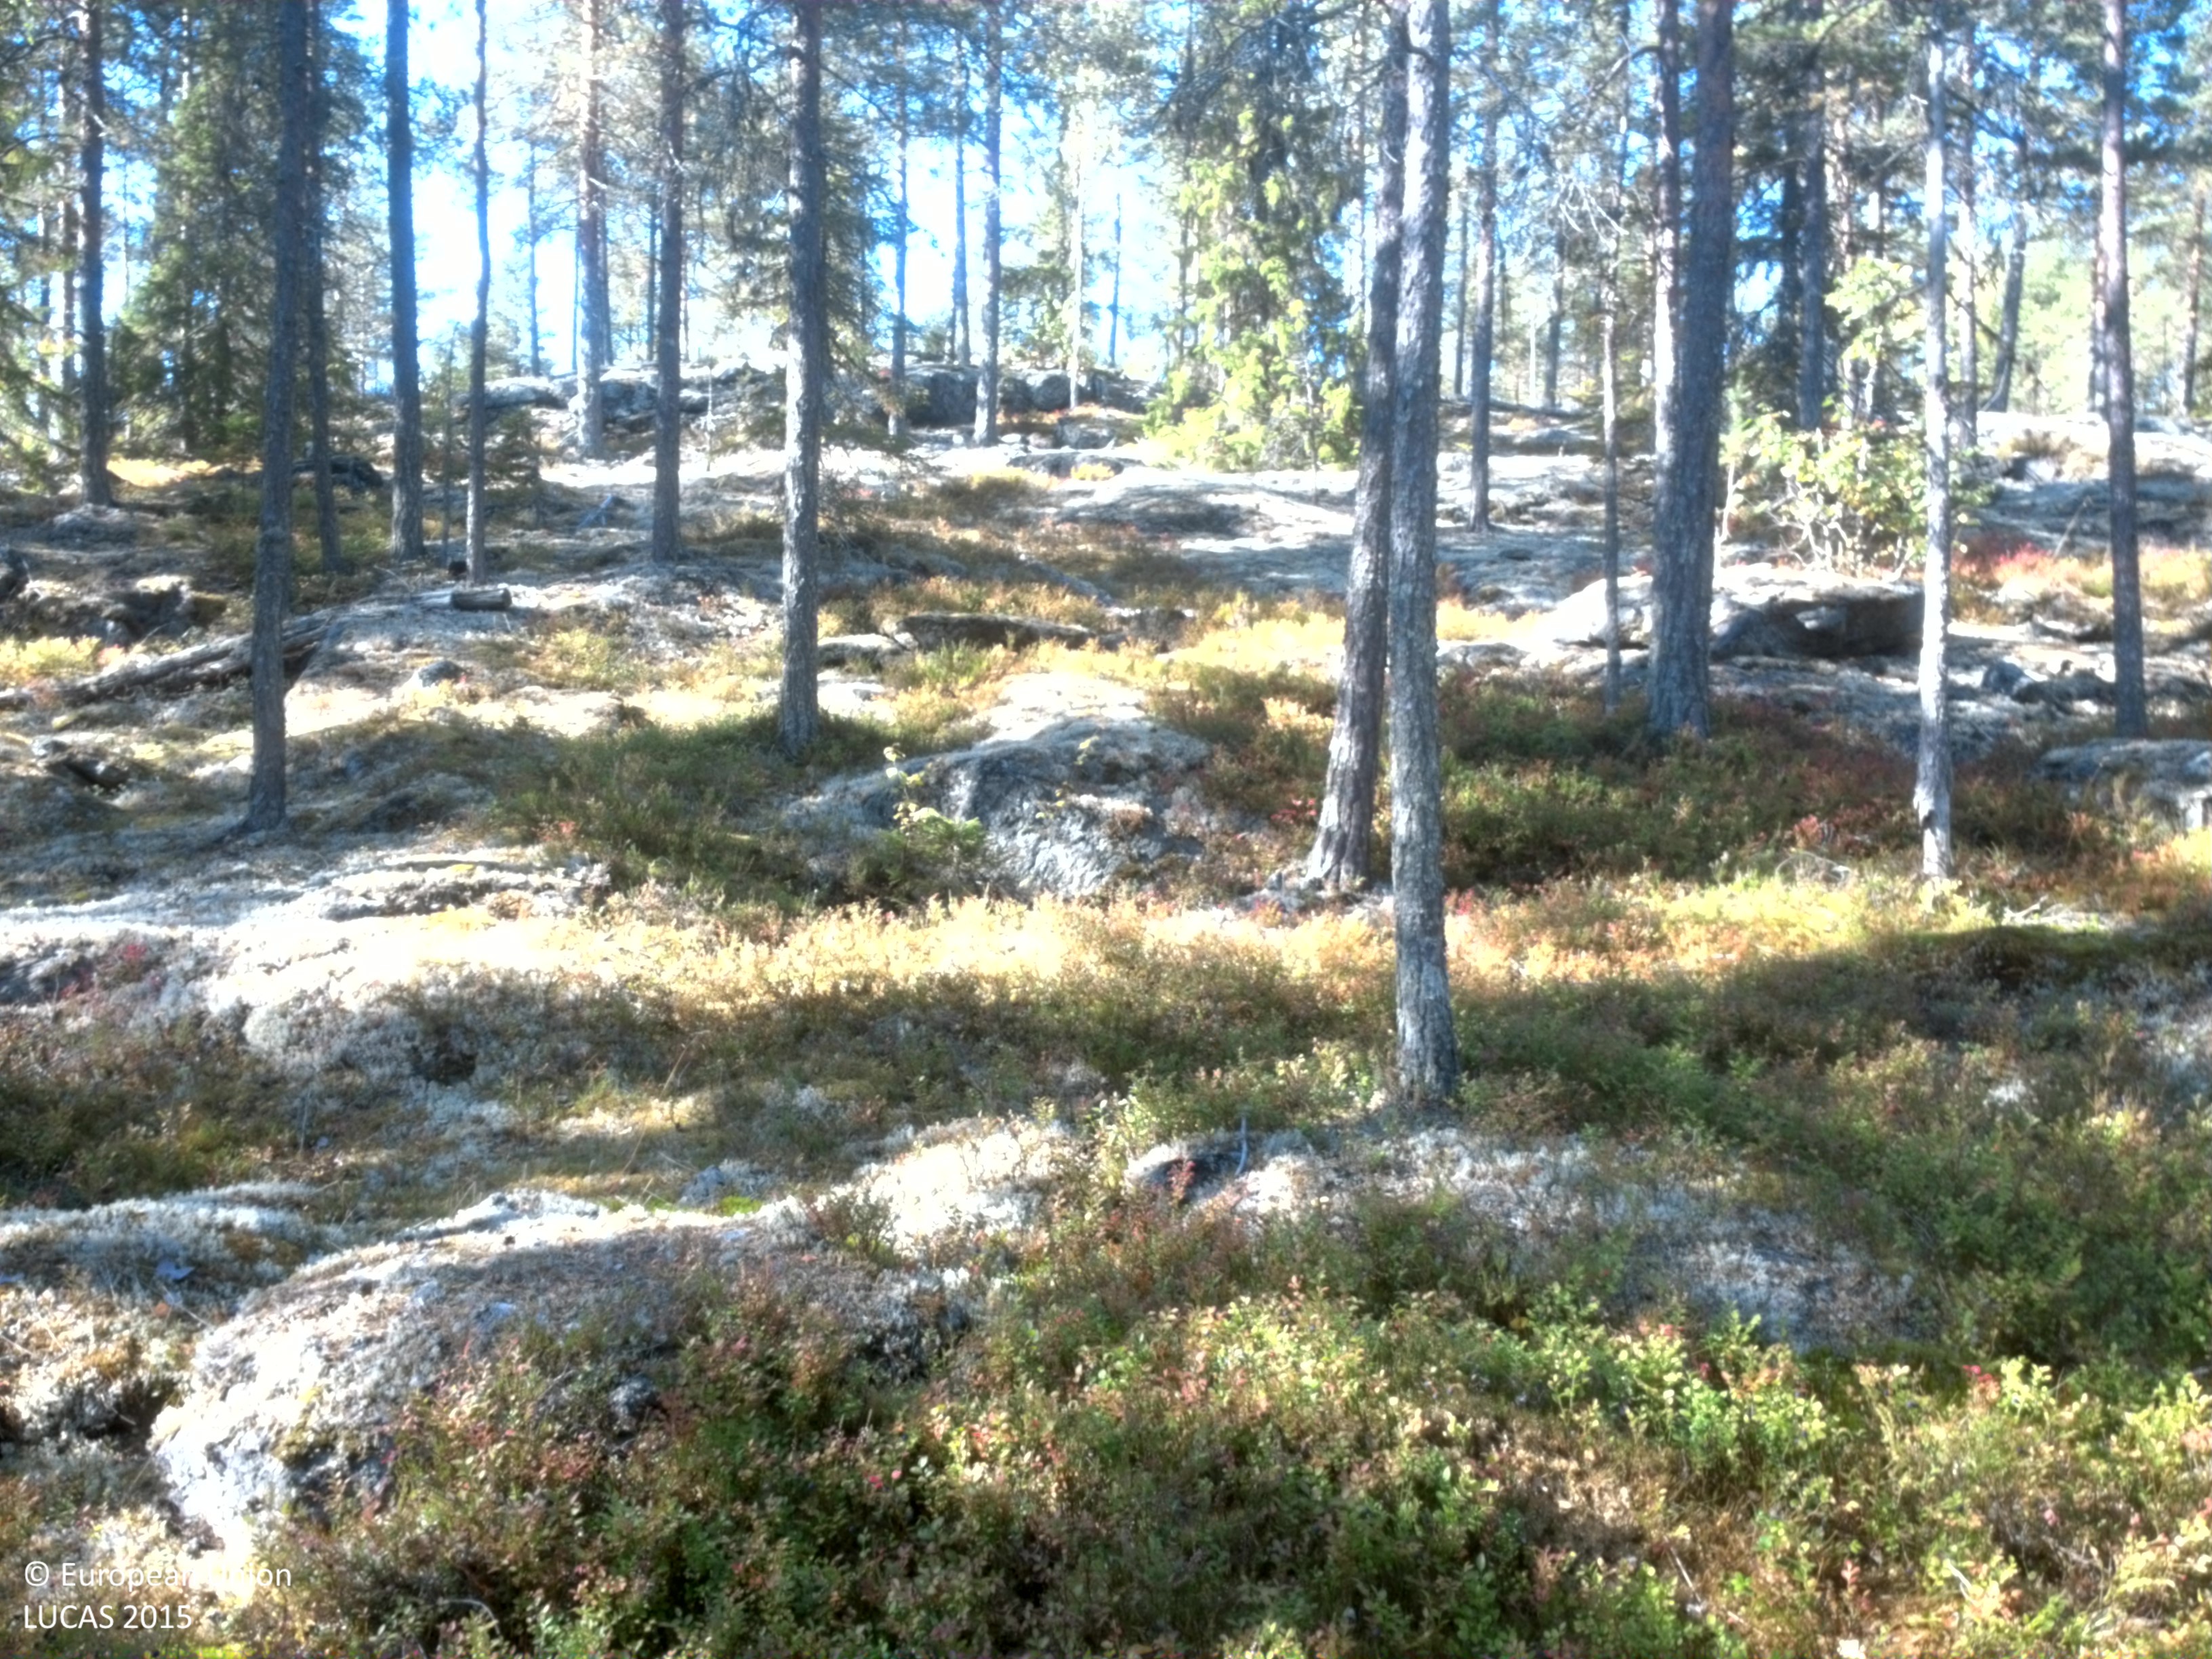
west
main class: Woodland
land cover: Pine dominated coniferous woodland
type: boreal forest
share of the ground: 50 - 75 %
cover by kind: coniferous forest trees 55 %, shrubs 35 %, lichens and mosses 5 %, consolidated bare surface 5 %
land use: Forestry
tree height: > 5 m
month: September
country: SE
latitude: 64.2470
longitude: 19.6906
